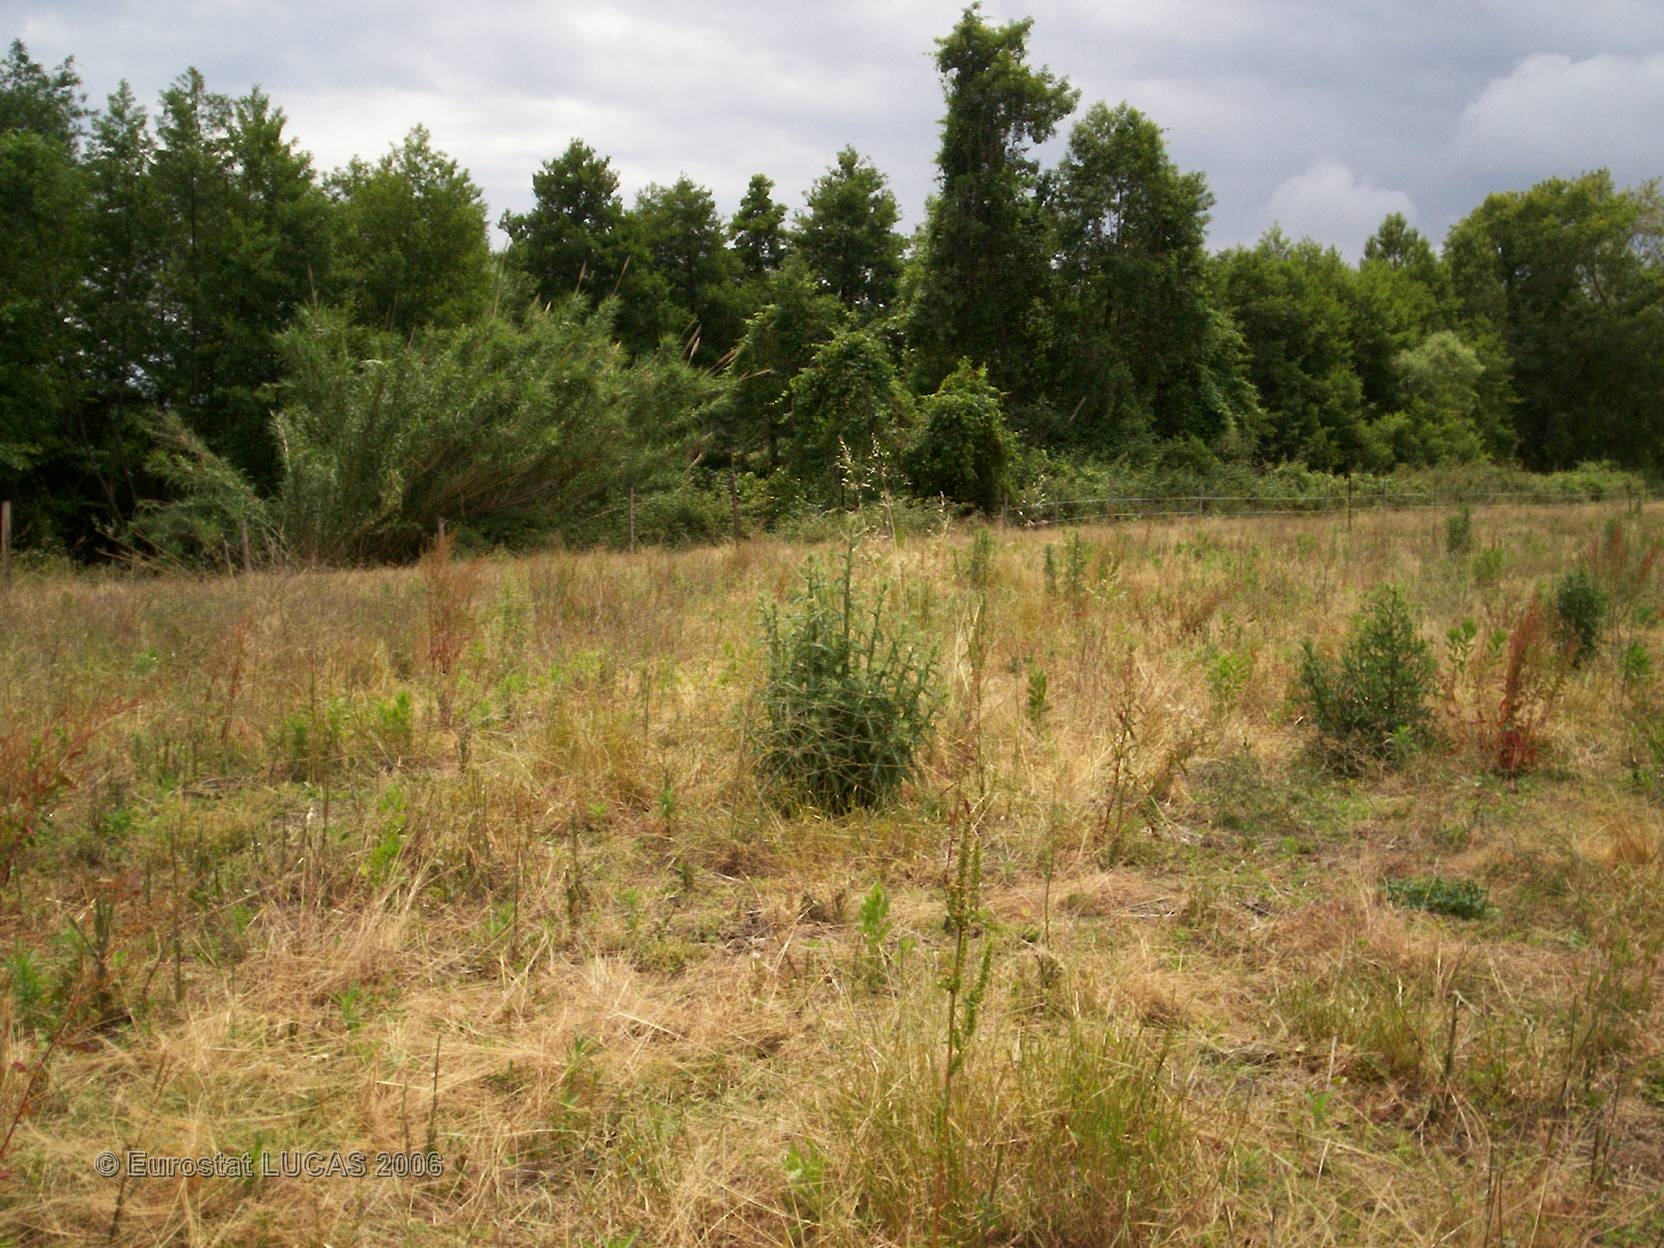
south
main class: Grassland
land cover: Grassland without tree/shrub cover
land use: Agriculture (excluding fallow land and kitchen gardens)
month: June
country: FR
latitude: 42.2916
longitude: 9.5287
